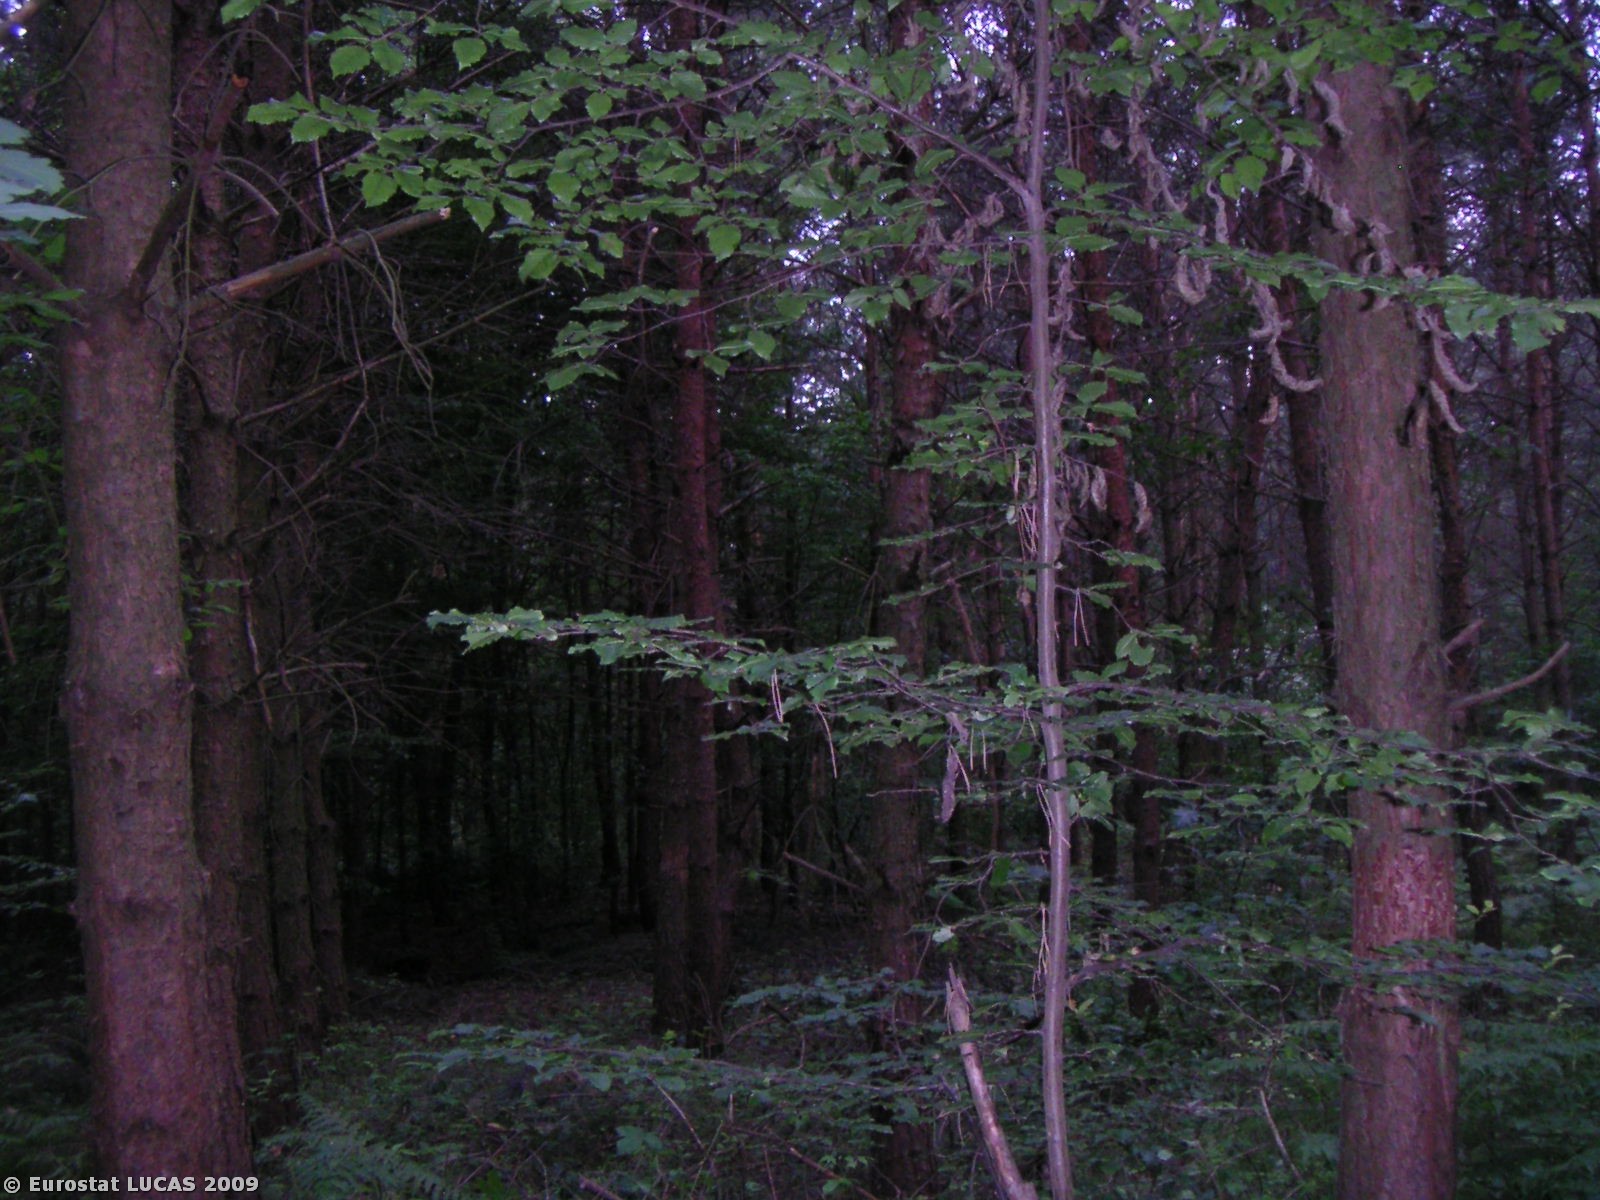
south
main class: Woodland
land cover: Coniferous woodland
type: hemiboreal forest and nemoral coniferous forest and mixed broadleaved-coniferous forest
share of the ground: > 75 %
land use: Forestry
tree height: > 5 m
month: July
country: PL
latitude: 50.5441
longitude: 19.7529
